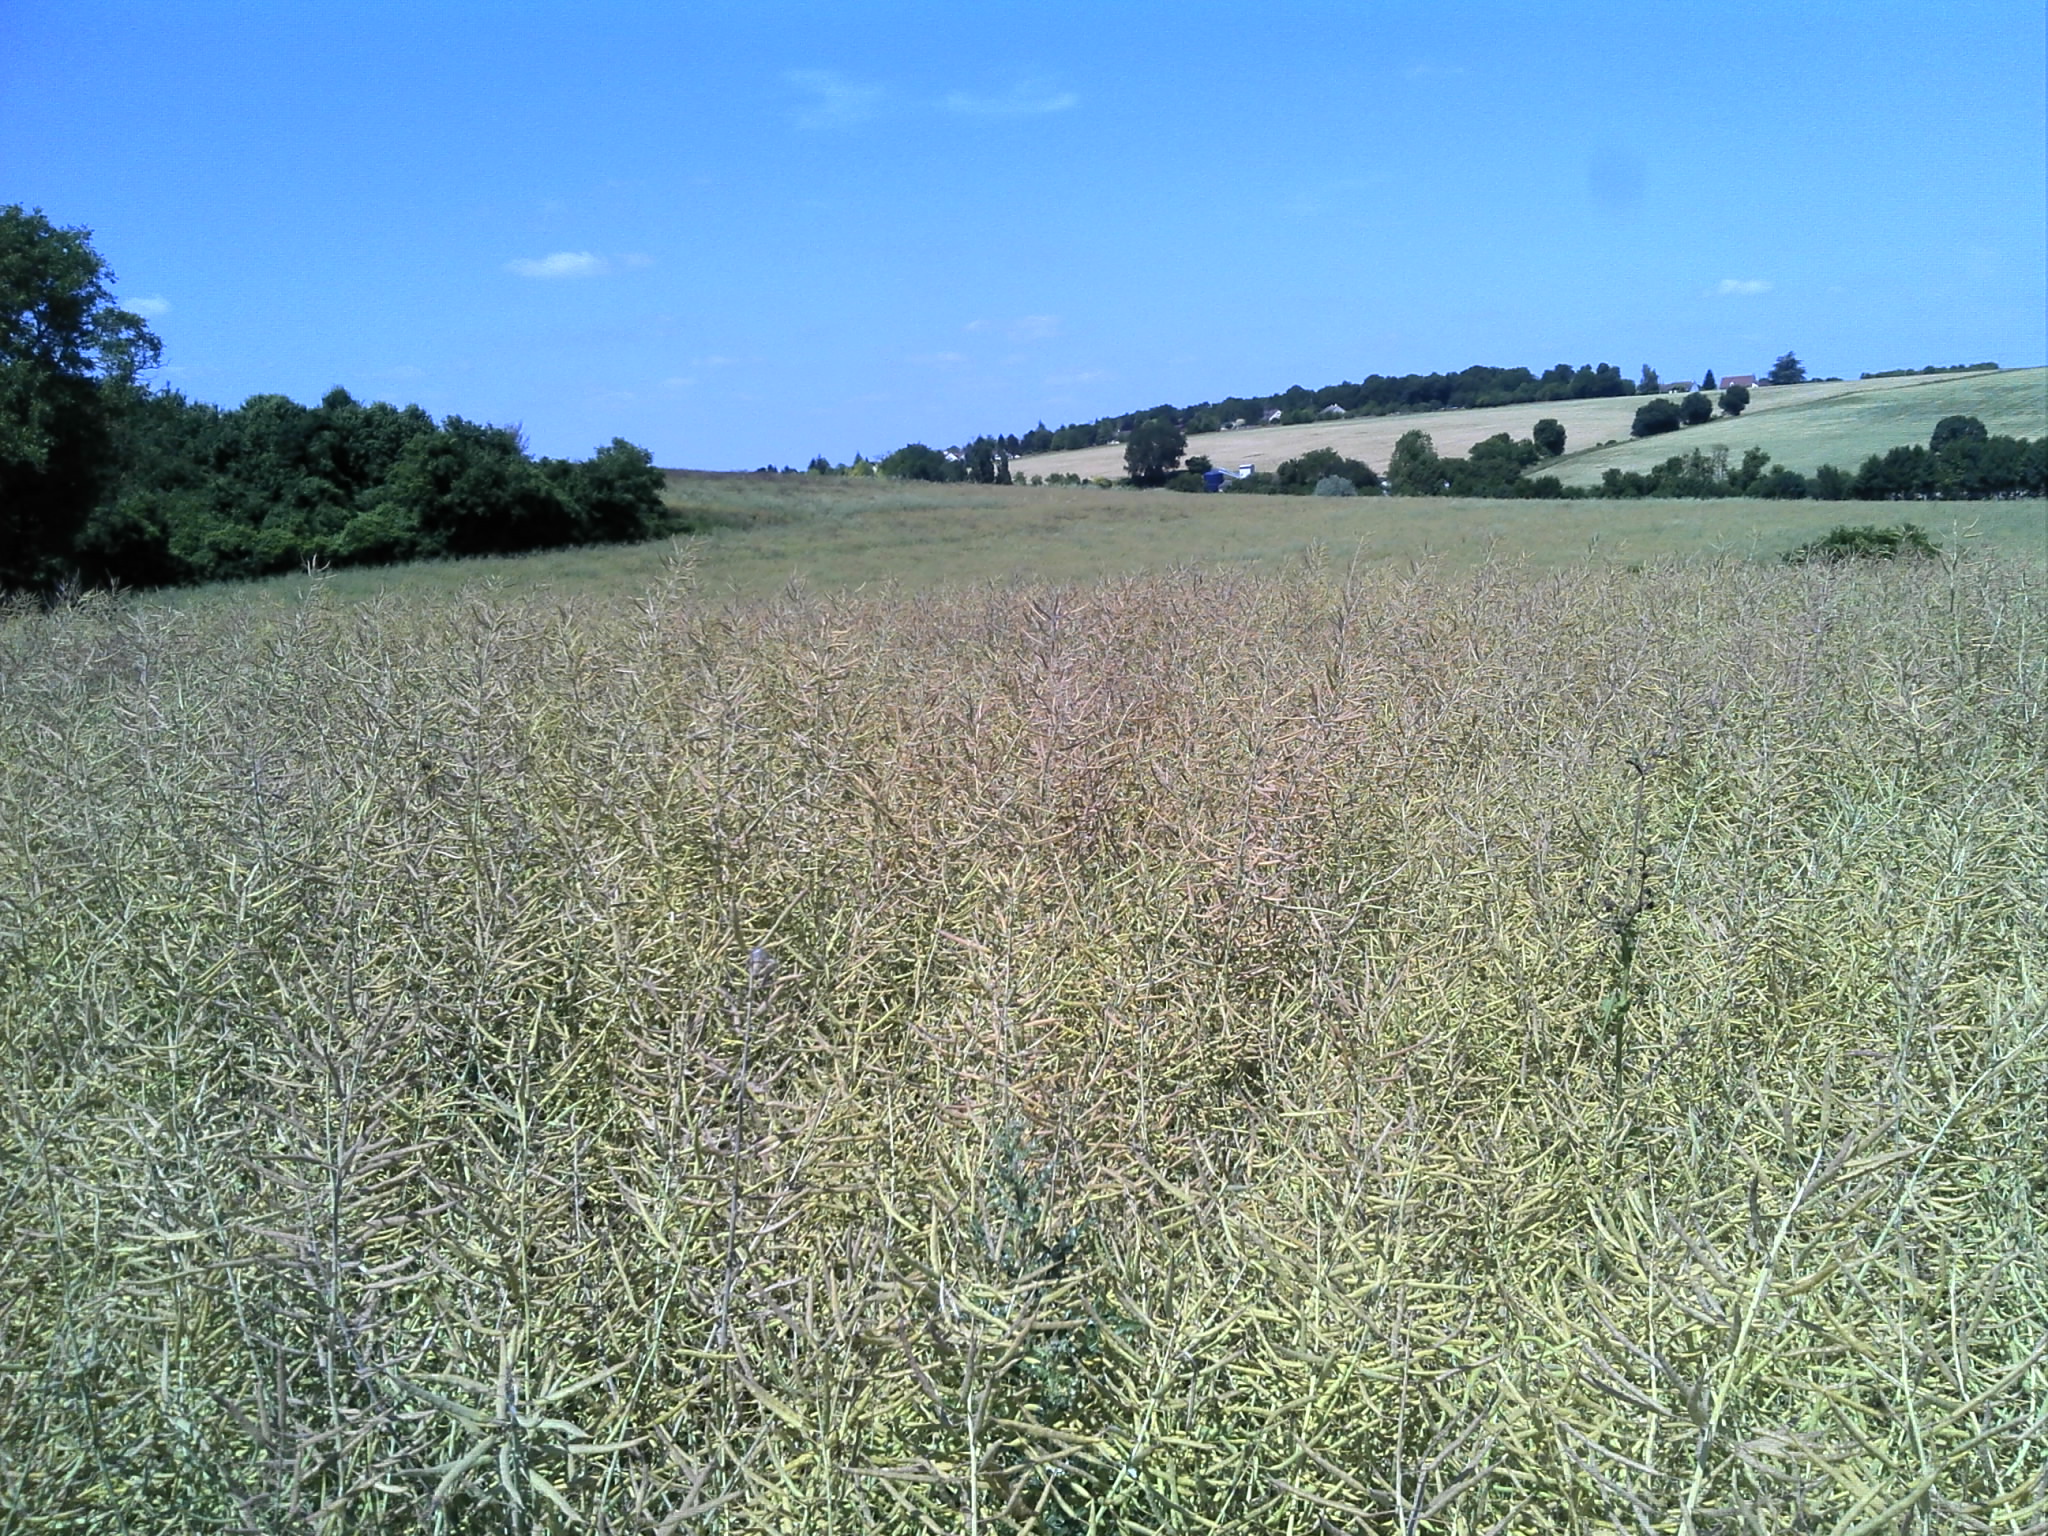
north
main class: Cropland
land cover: Rape and turnip rape
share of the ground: > 75 %
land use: Agriculture (excluding fallow land and kitchen gardens)
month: June
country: FR
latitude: 47.1115
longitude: 1.4342
